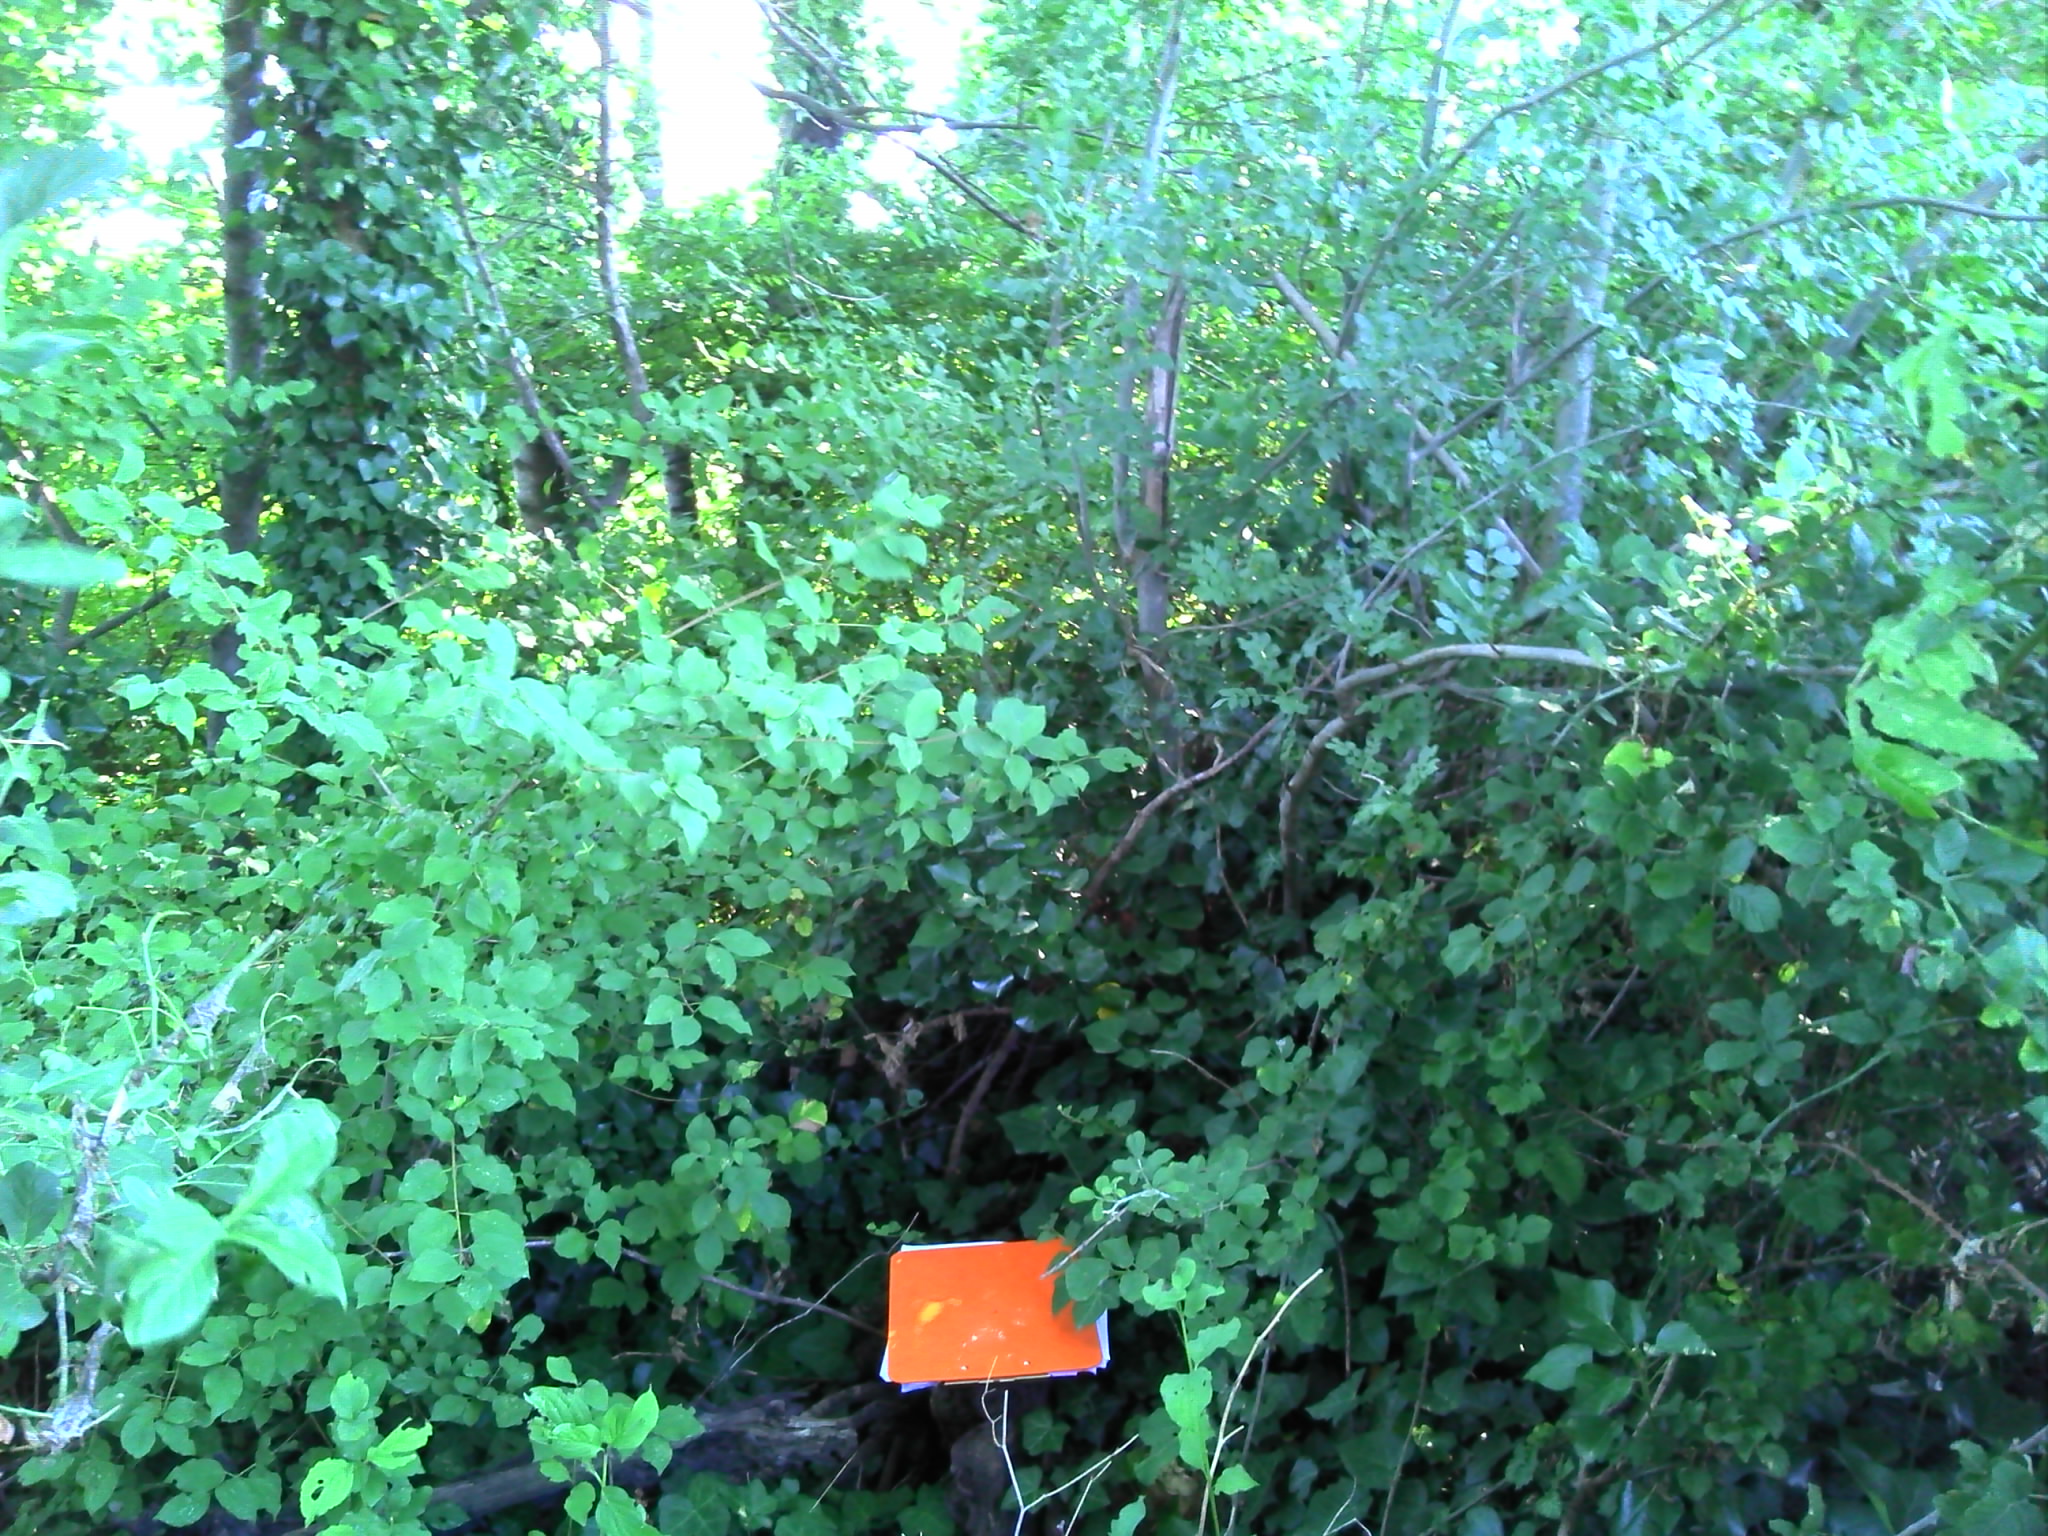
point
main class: Woodland
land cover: Broadleaved woodland
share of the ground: > 75 %
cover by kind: broadleaved forest trees 70 %, herbaceous plants 20 %, consolidated bare surface 10 %
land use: Semi-natural and natural areas not in use
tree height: > 5 m
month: August
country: FR
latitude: 44.1580
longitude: 4.6436
